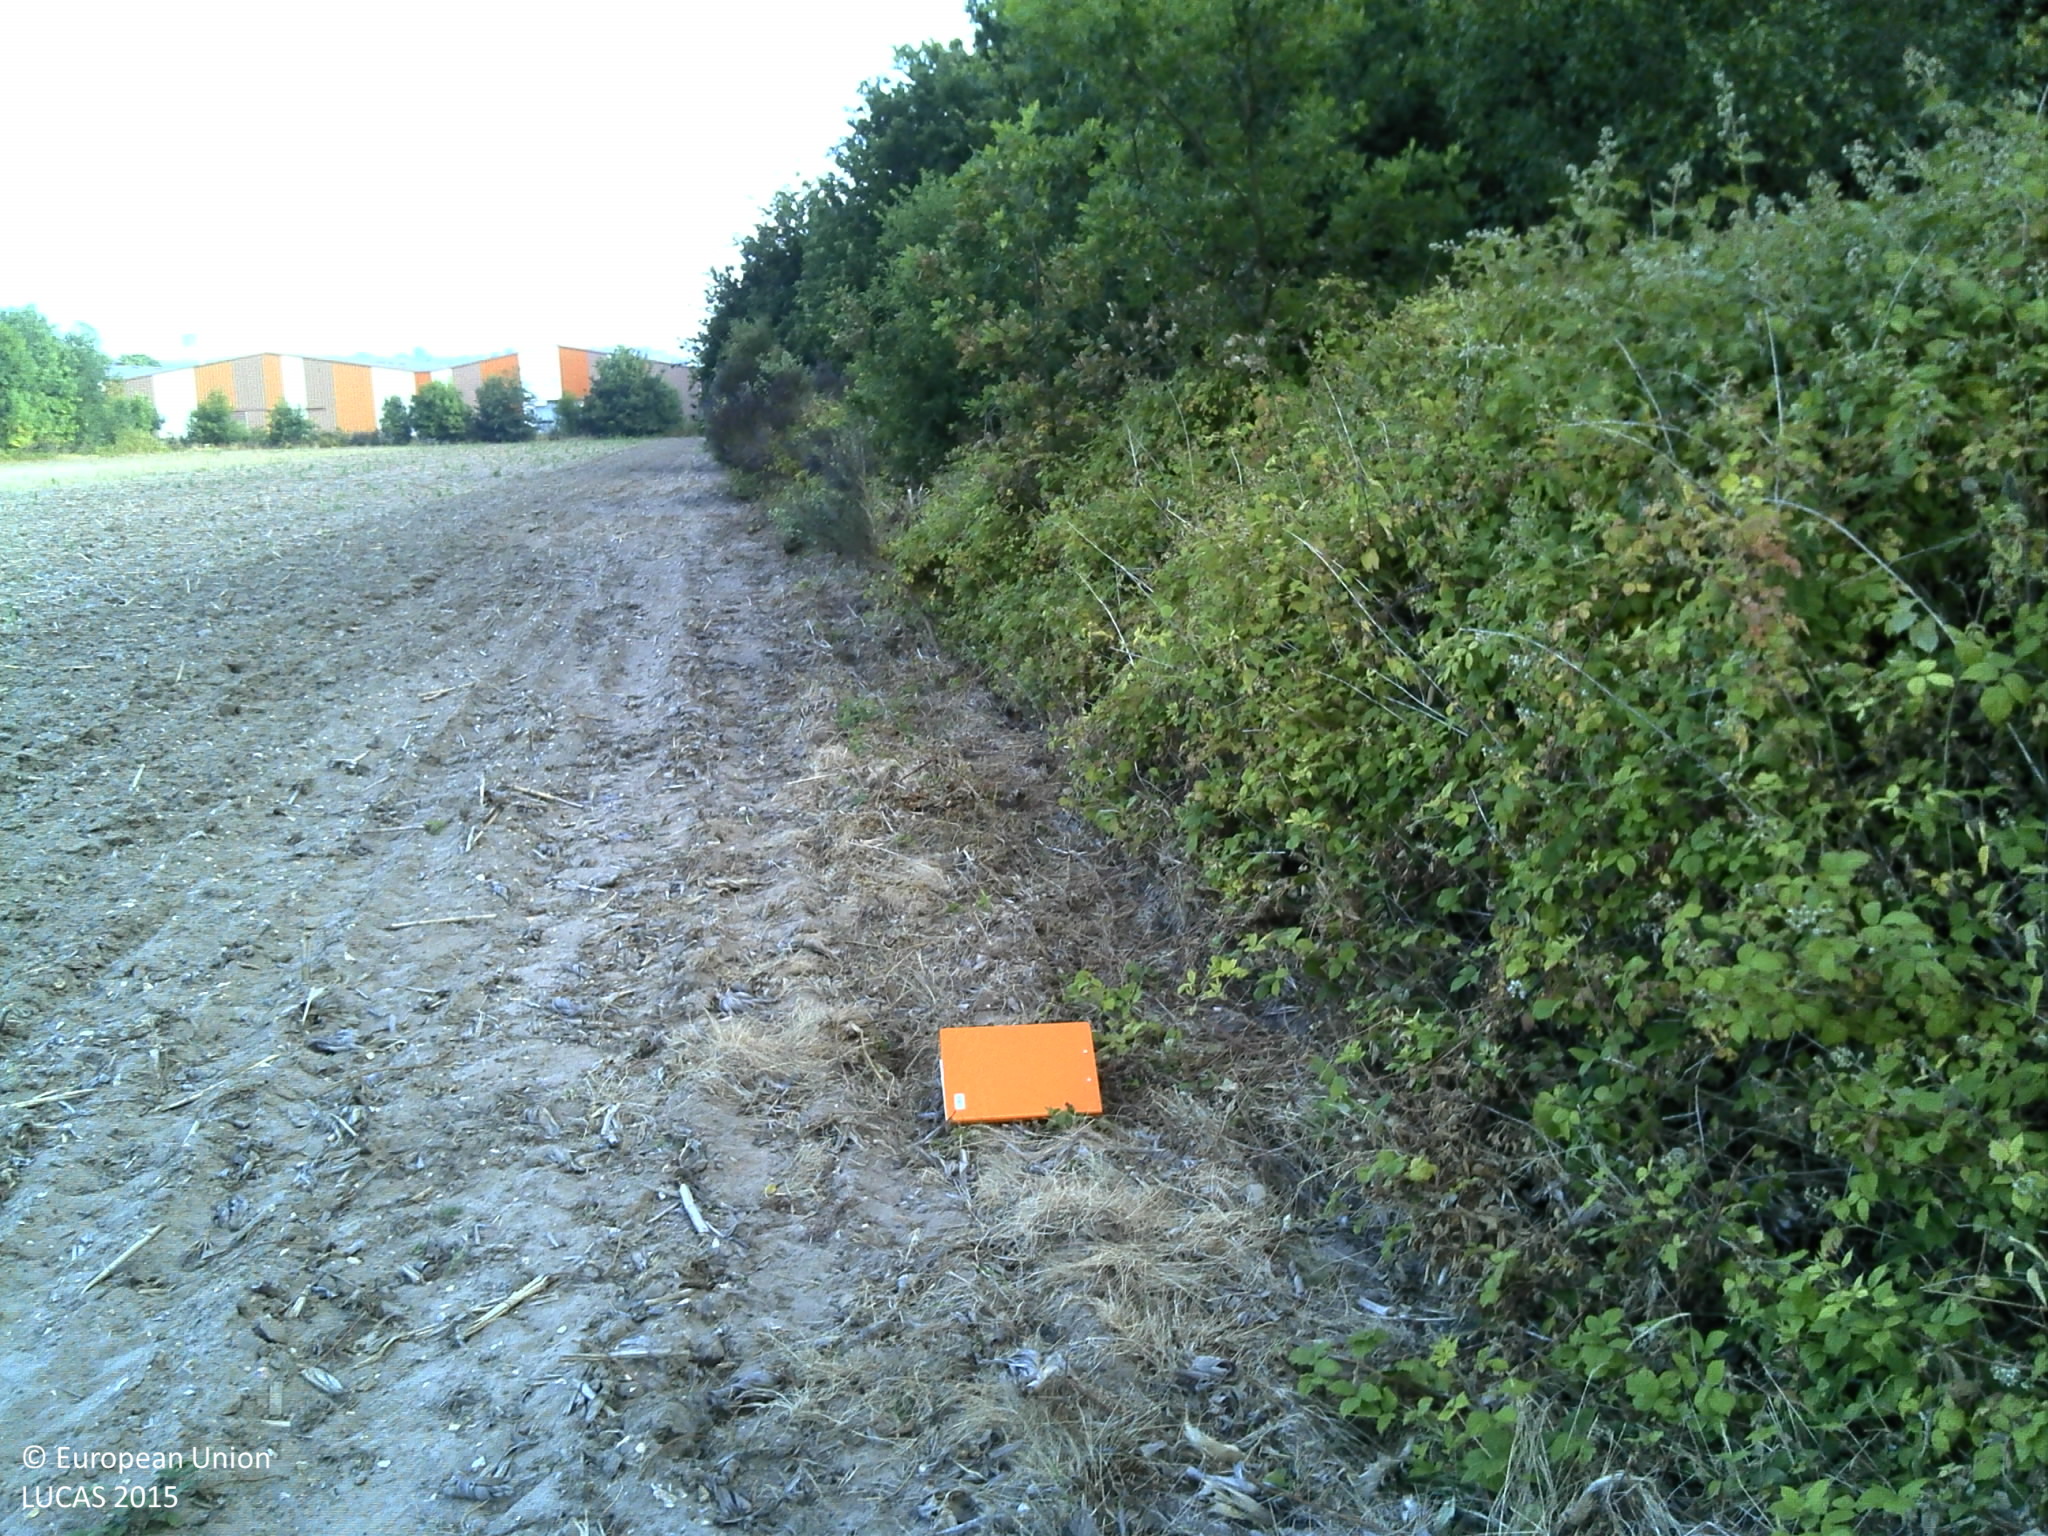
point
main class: Woodland
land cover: Broadleaved woodland
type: acidophilous oak and oak-birch forest
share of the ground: > 75 %
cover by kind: broadleaved forest trees 100 %
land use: Forestry
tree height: > 5 m
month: June
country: FR
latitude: 49.2893
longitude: 1.0554
